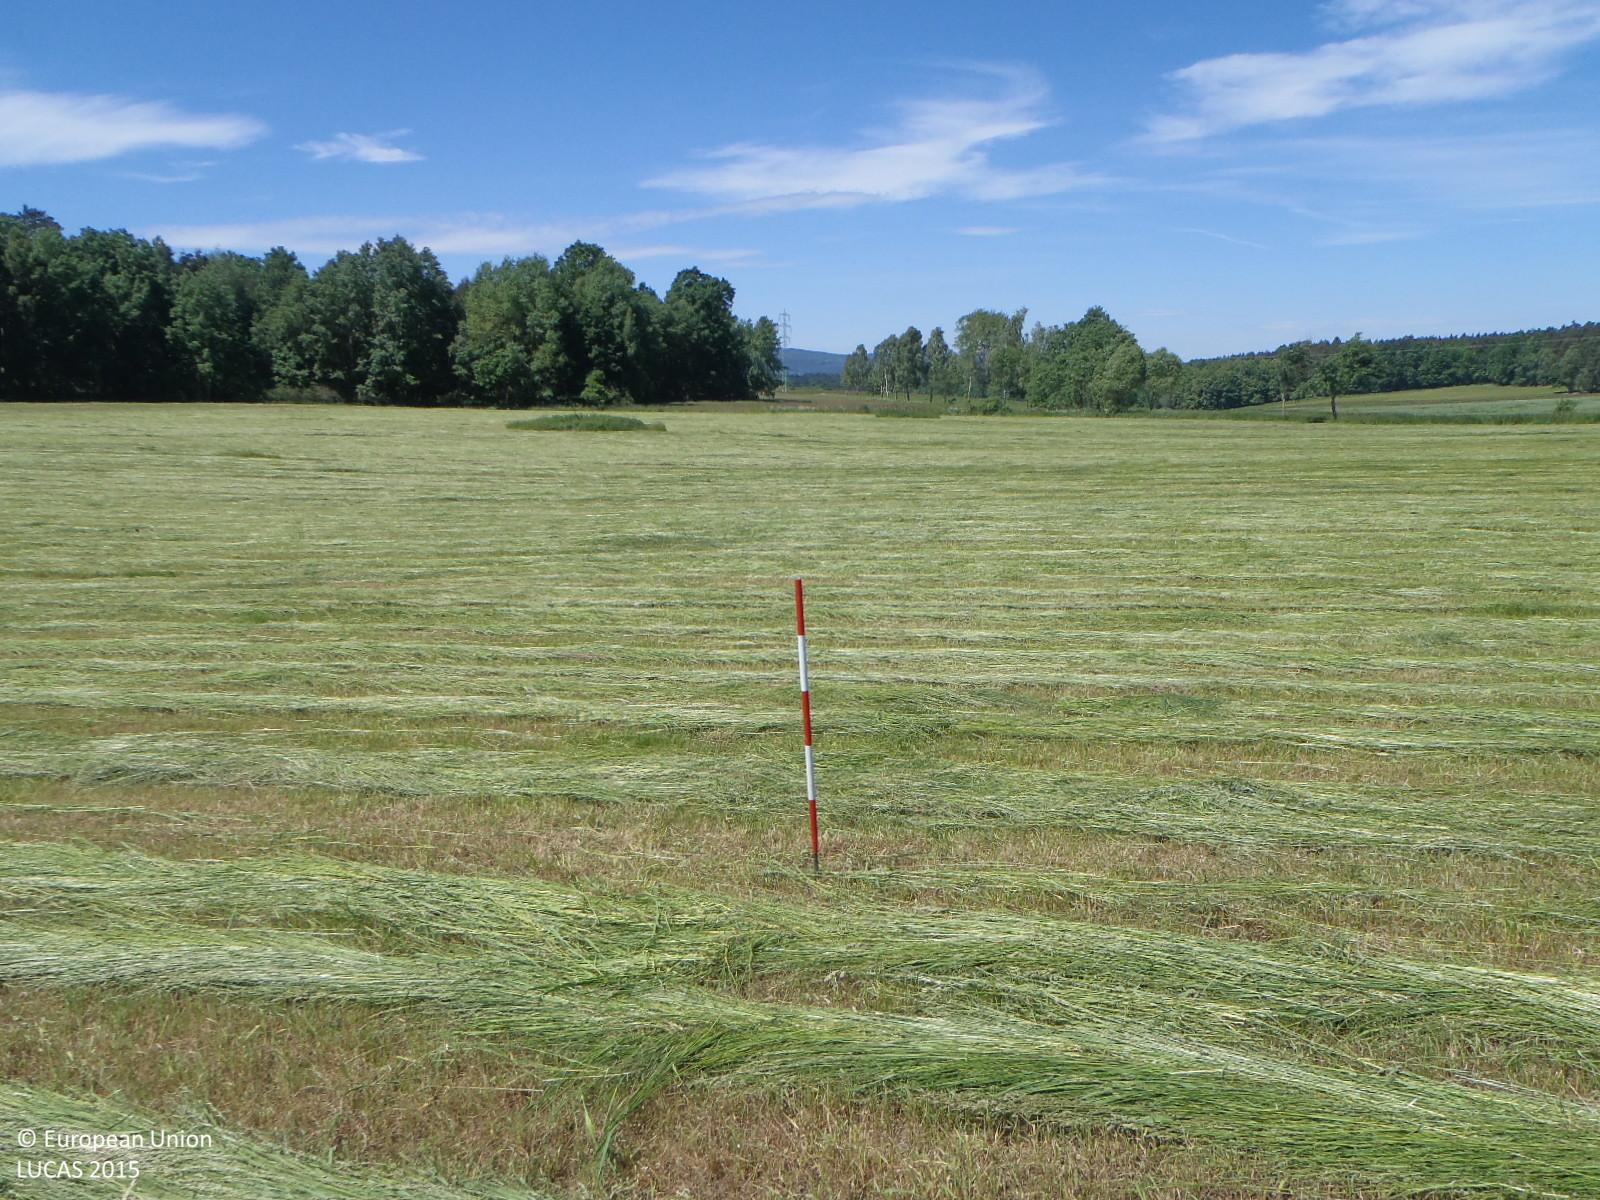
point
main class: Grassland
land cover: Grassland without tree/shrub cover
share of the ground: > 75 %
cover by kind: herbaceous plants 100 %
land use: Agriculture (excluding fallow land and kitchen gardens)
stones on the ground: < 10 %
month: June
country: CZ
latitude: 48.8912
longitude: 14.4337
